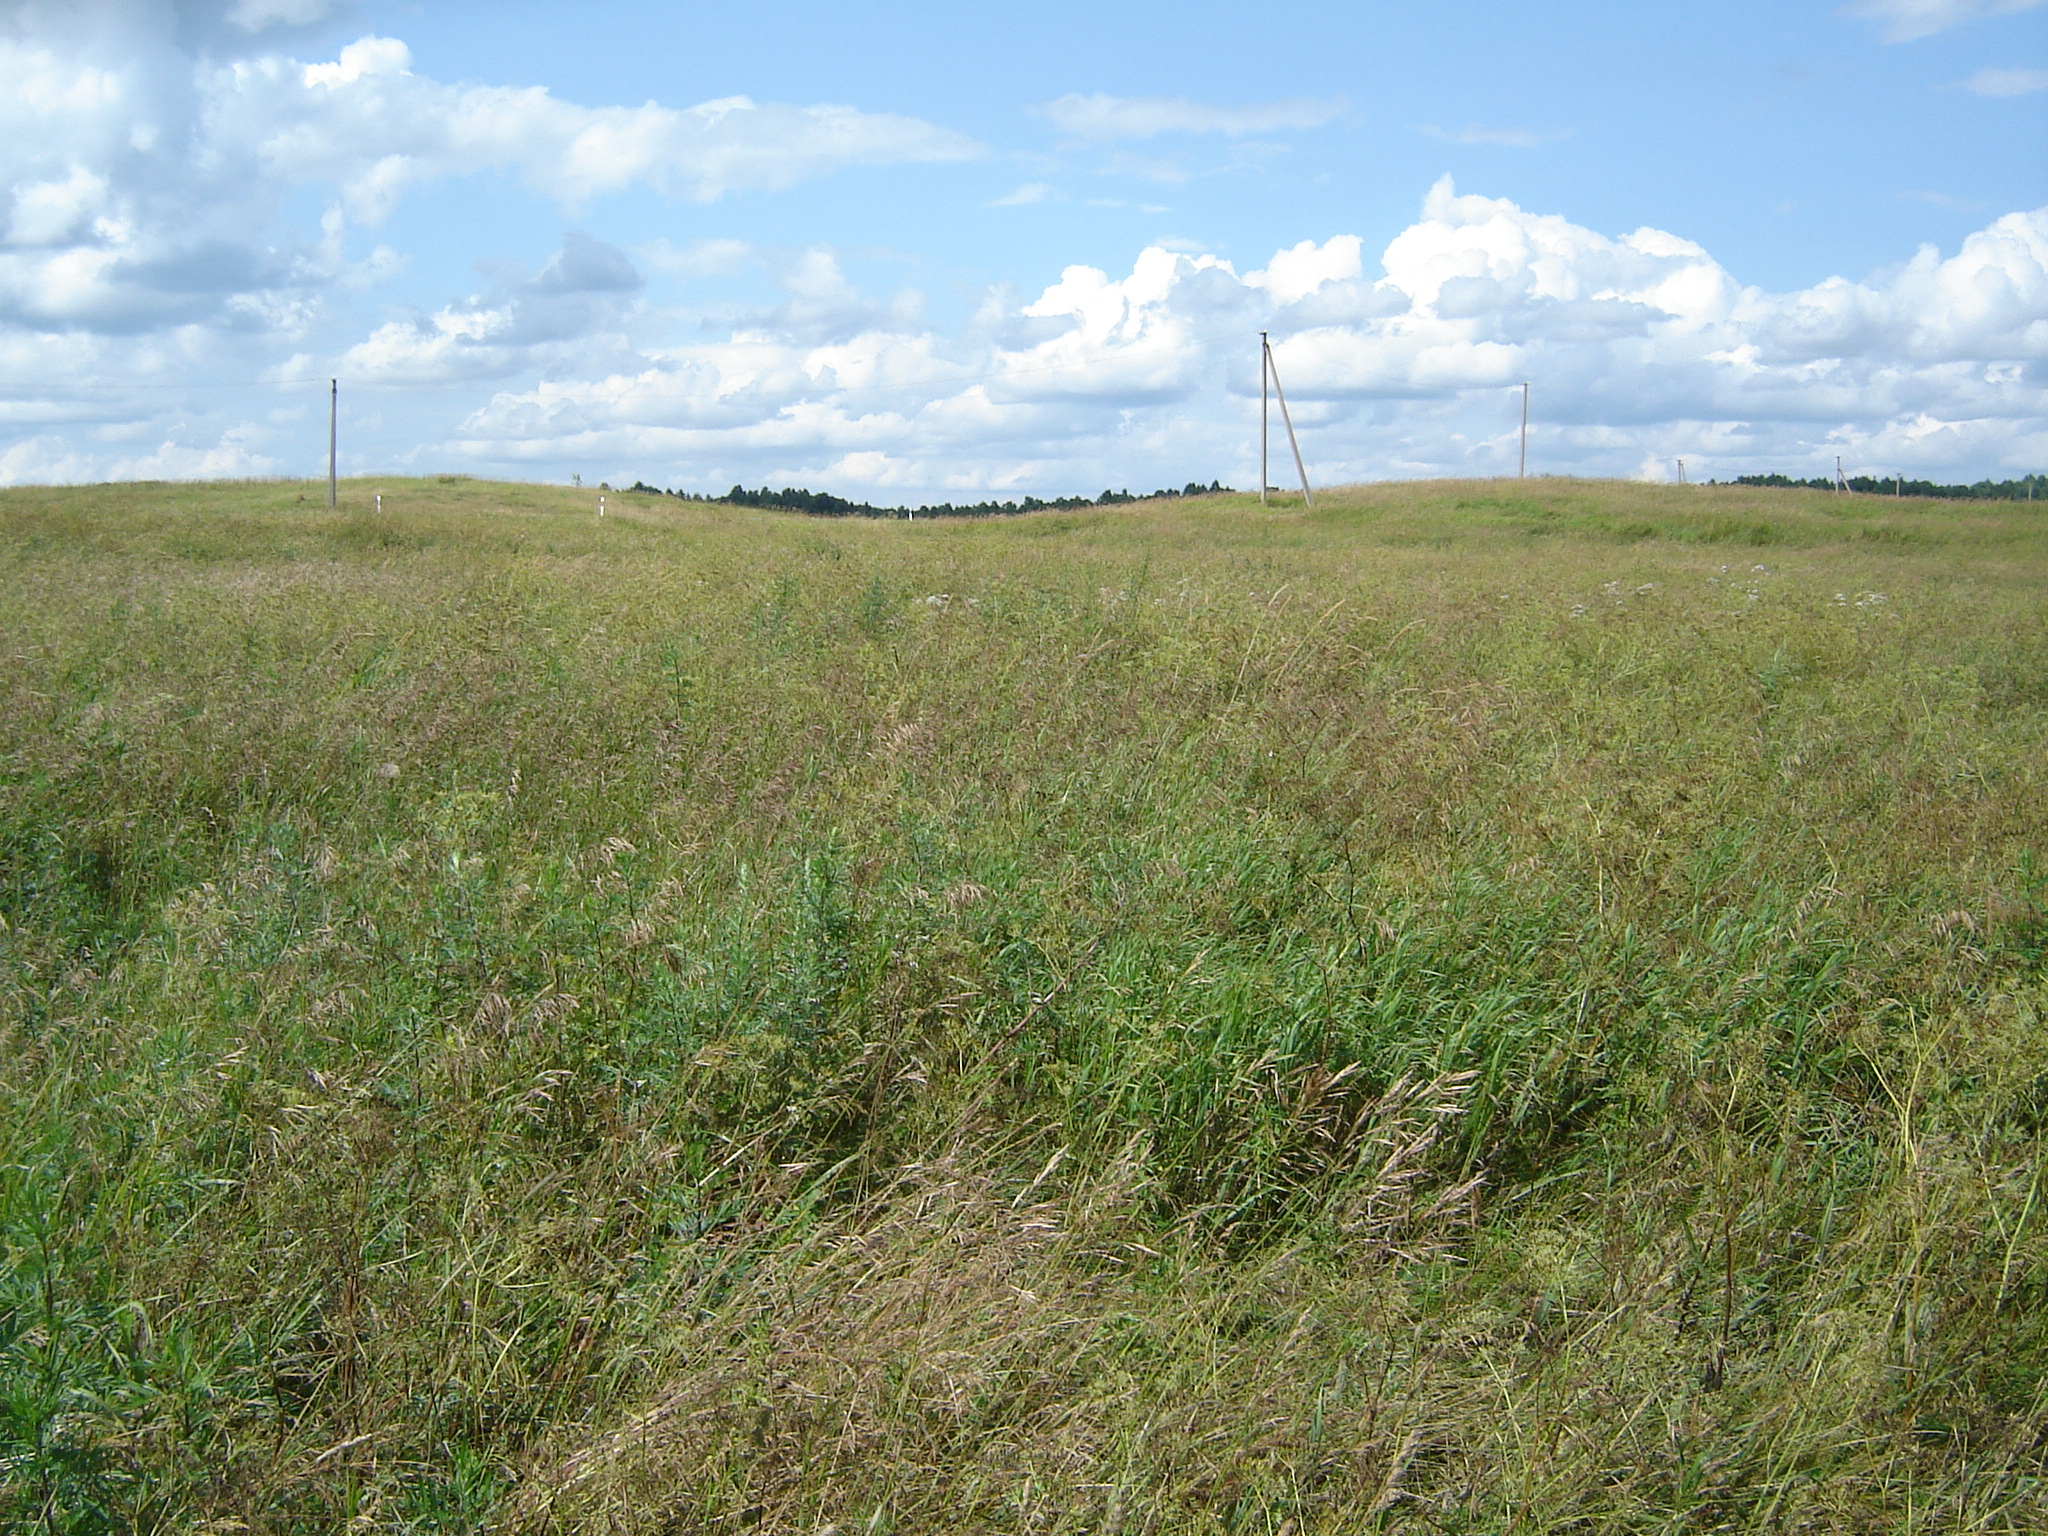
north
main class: Grassland
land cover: Grassland without tree/shrub cover
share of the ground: > 75 %
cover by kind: herbaceous plants 100 %
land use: Agriculture (excluding fallow land and kitchen gardens)
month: July
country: LT
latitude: 55.2425
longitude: 25.4591
